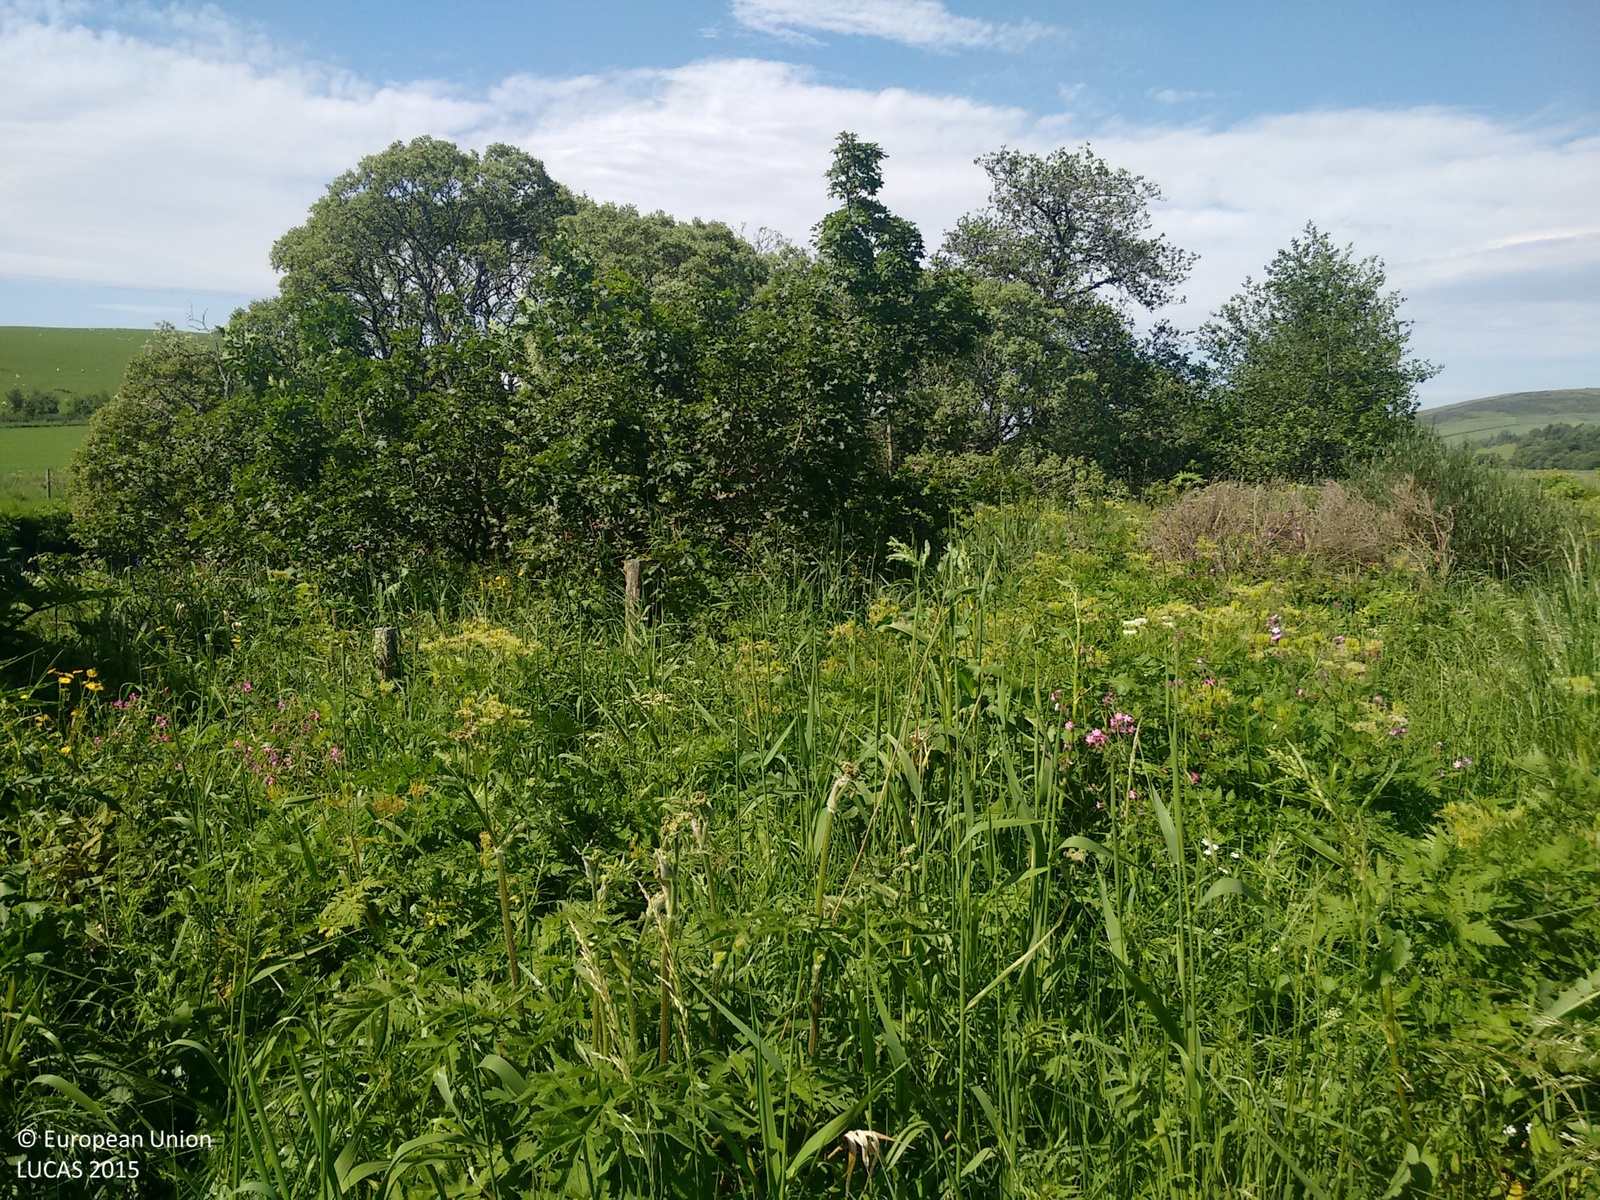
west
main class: Woodland
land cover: Broadleaved woodland
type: mesophytic deciduous forest
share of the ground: > 75 %
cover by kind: herbaceous plants 60 %, broadleaved forest trees 30 %, shrubs 10 %
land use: Semi-natural and natural areas not in use
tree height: > 5 m
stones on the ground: < 10 %
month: July
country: GB
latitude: 57.4509
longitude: -2.8745
